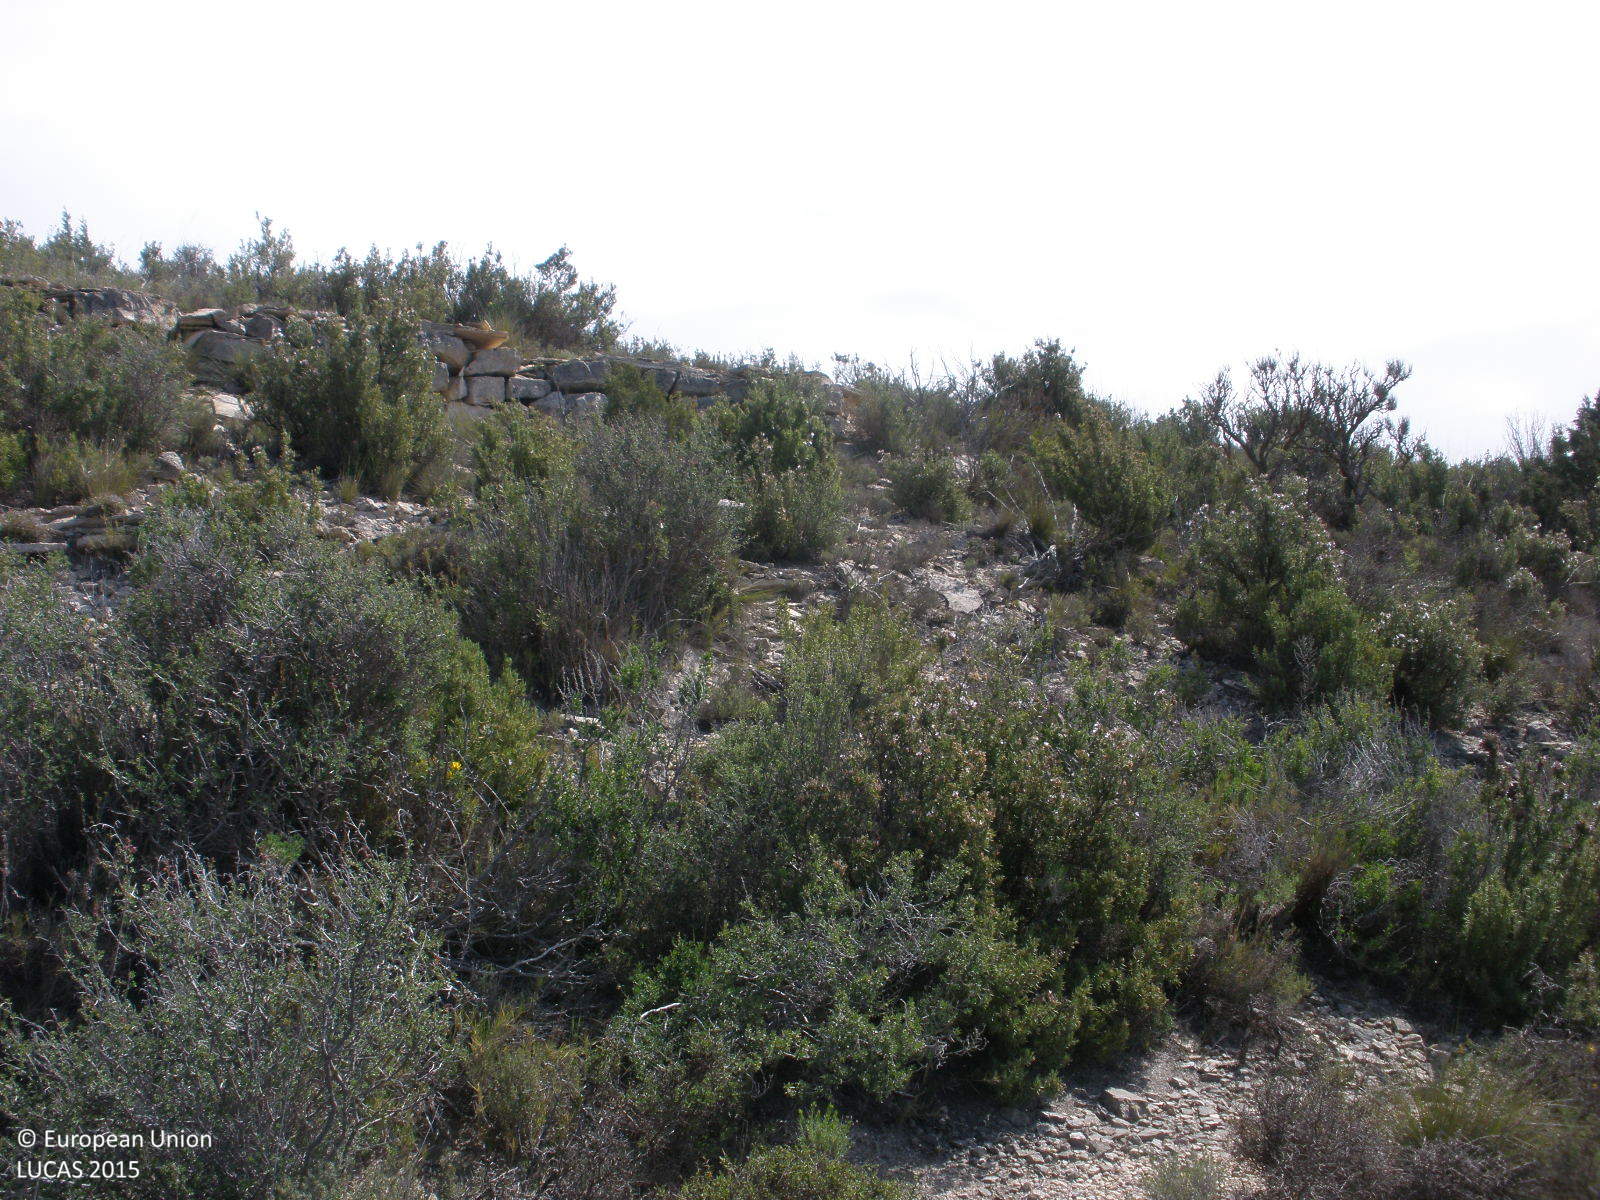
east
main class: Shrubland
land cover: Shrubland without tree cover
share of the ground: > 75 %
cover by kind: shrubs 80 %, consolidated bare surface 20 %
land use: Semi-natural and natural areas not in use
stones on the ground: 25 - 50 %
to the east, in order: Shrubland without tree cover; Dry stone walls; Shrubland without tree cover; Other coniferous woodland
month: April
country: ES
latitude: 40.1534
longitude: -1.1971
